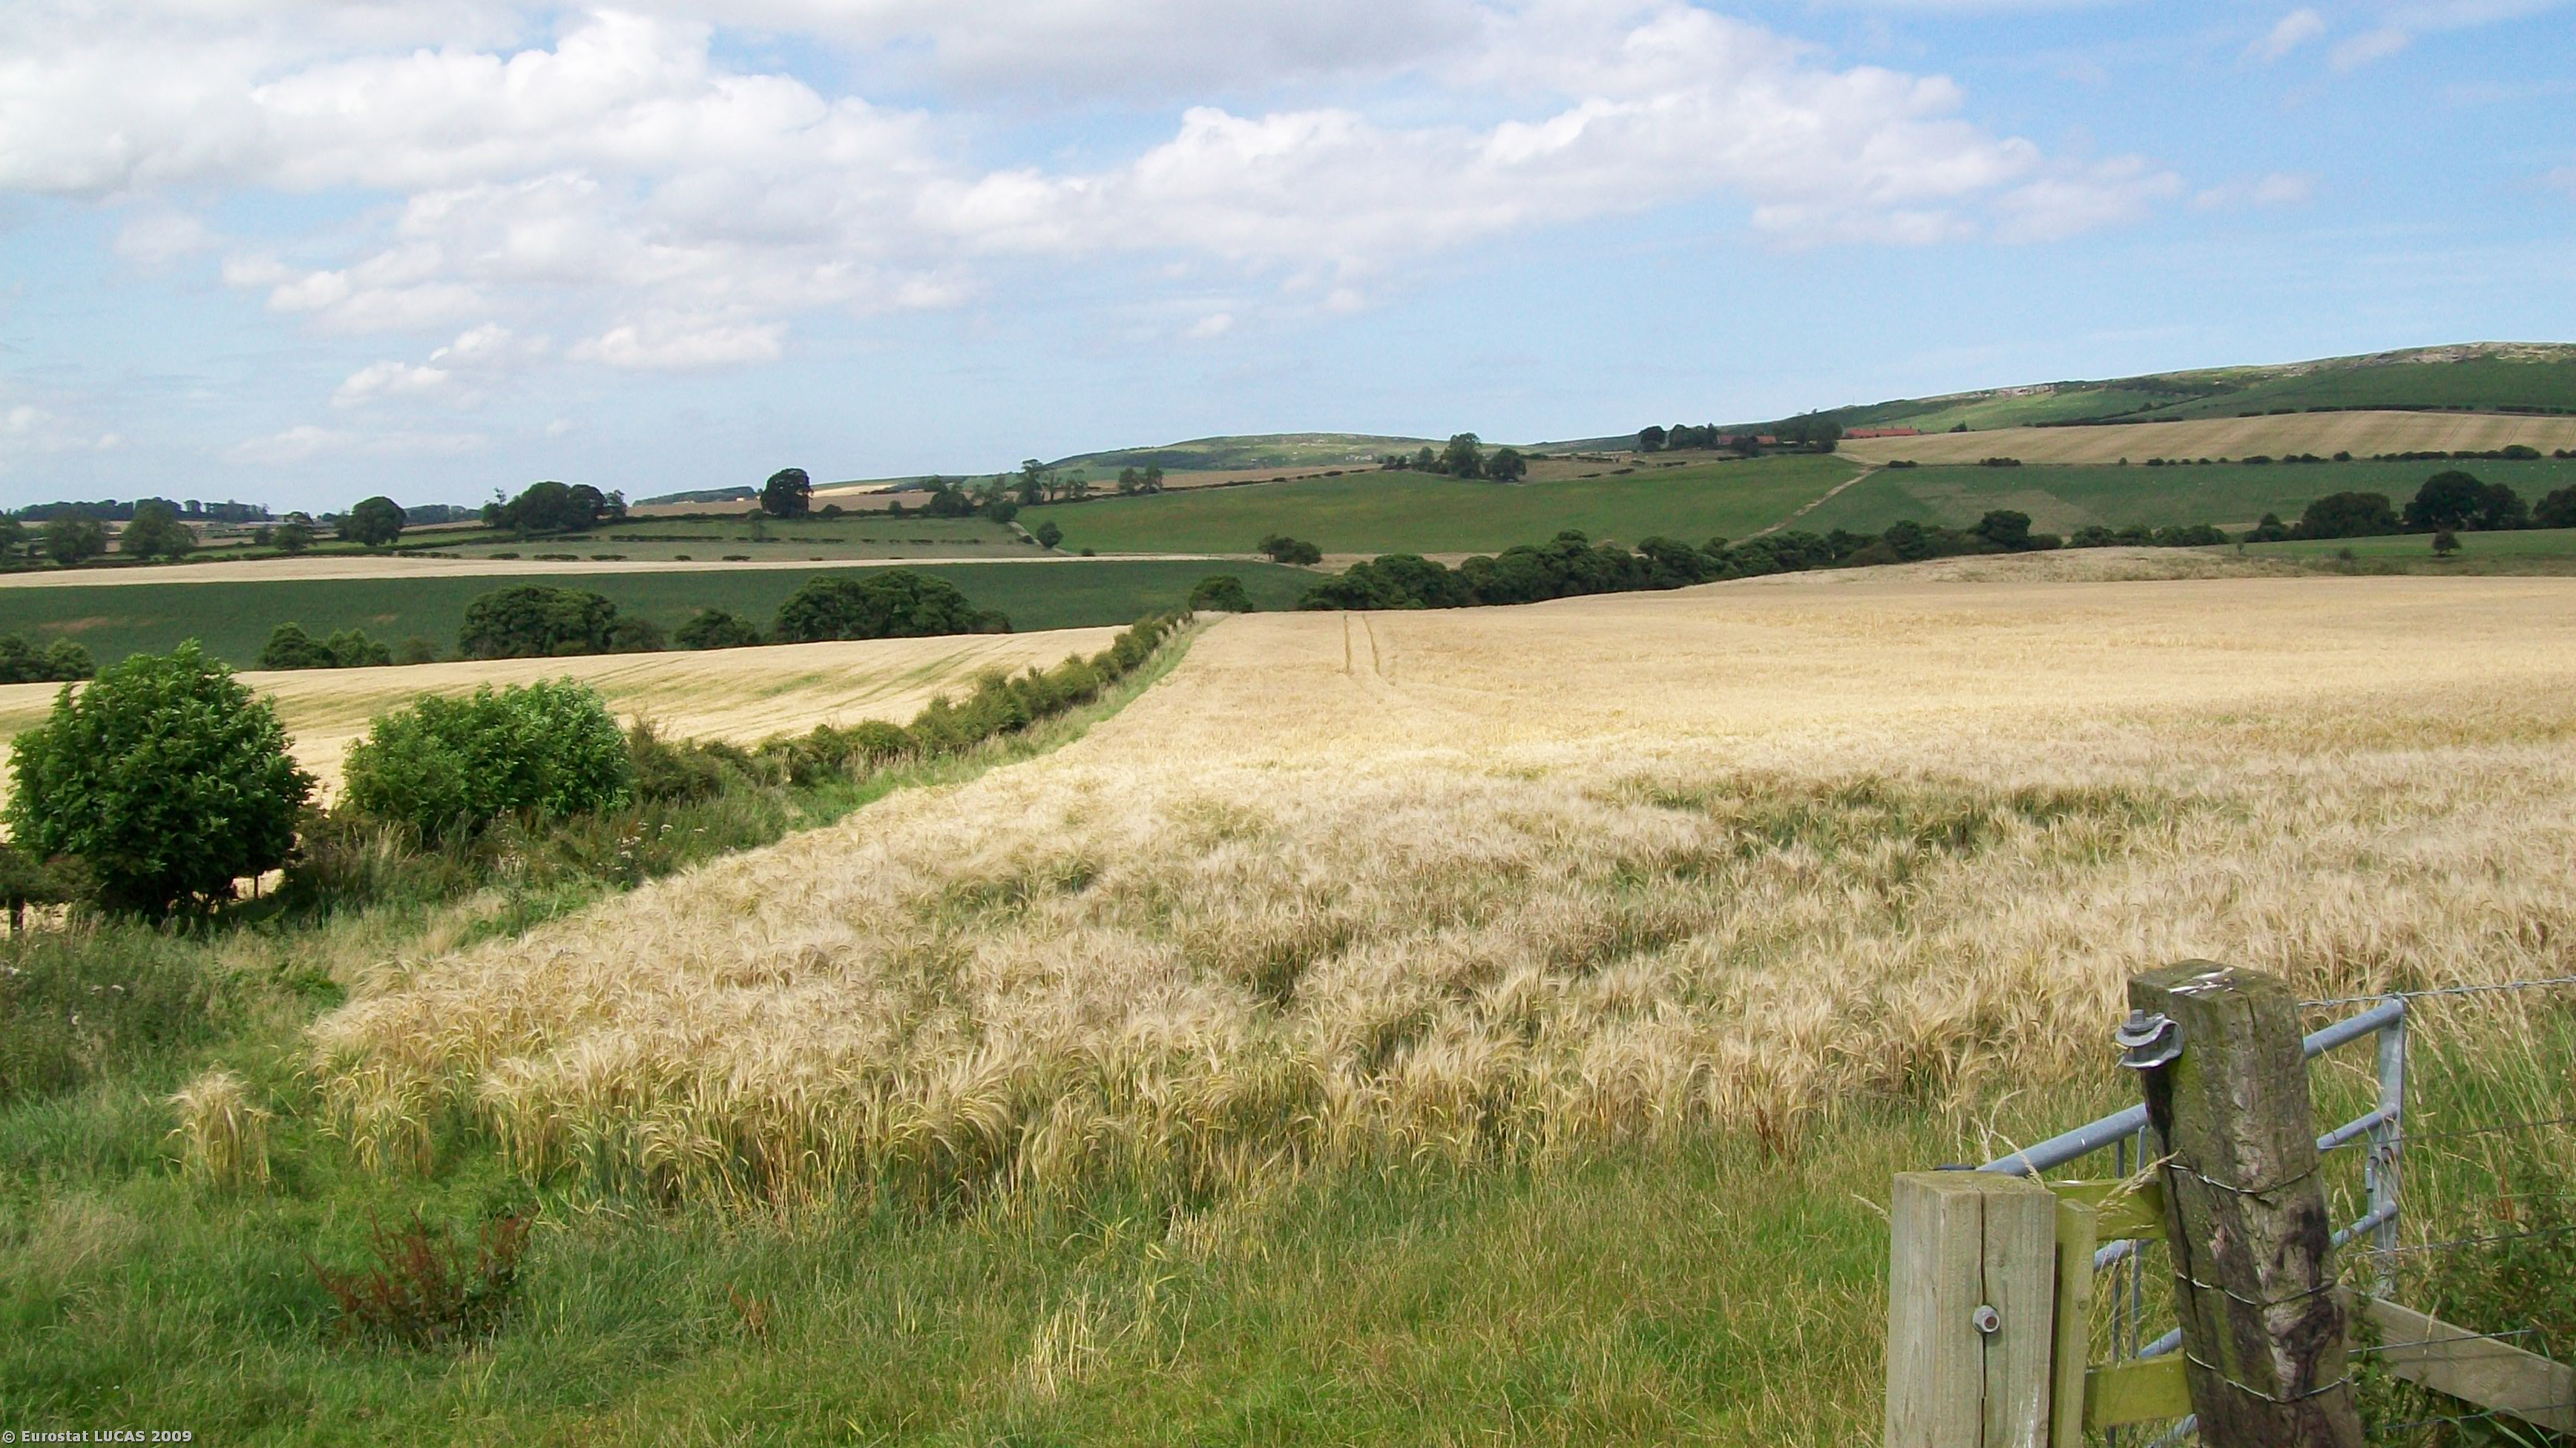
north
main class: Cropland
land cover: Barley
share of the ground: > 75 %
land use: Agriculture (excluding fallow land and kitchen gardens)
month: August
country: GB
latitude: 55.5594
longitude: -1.8947
